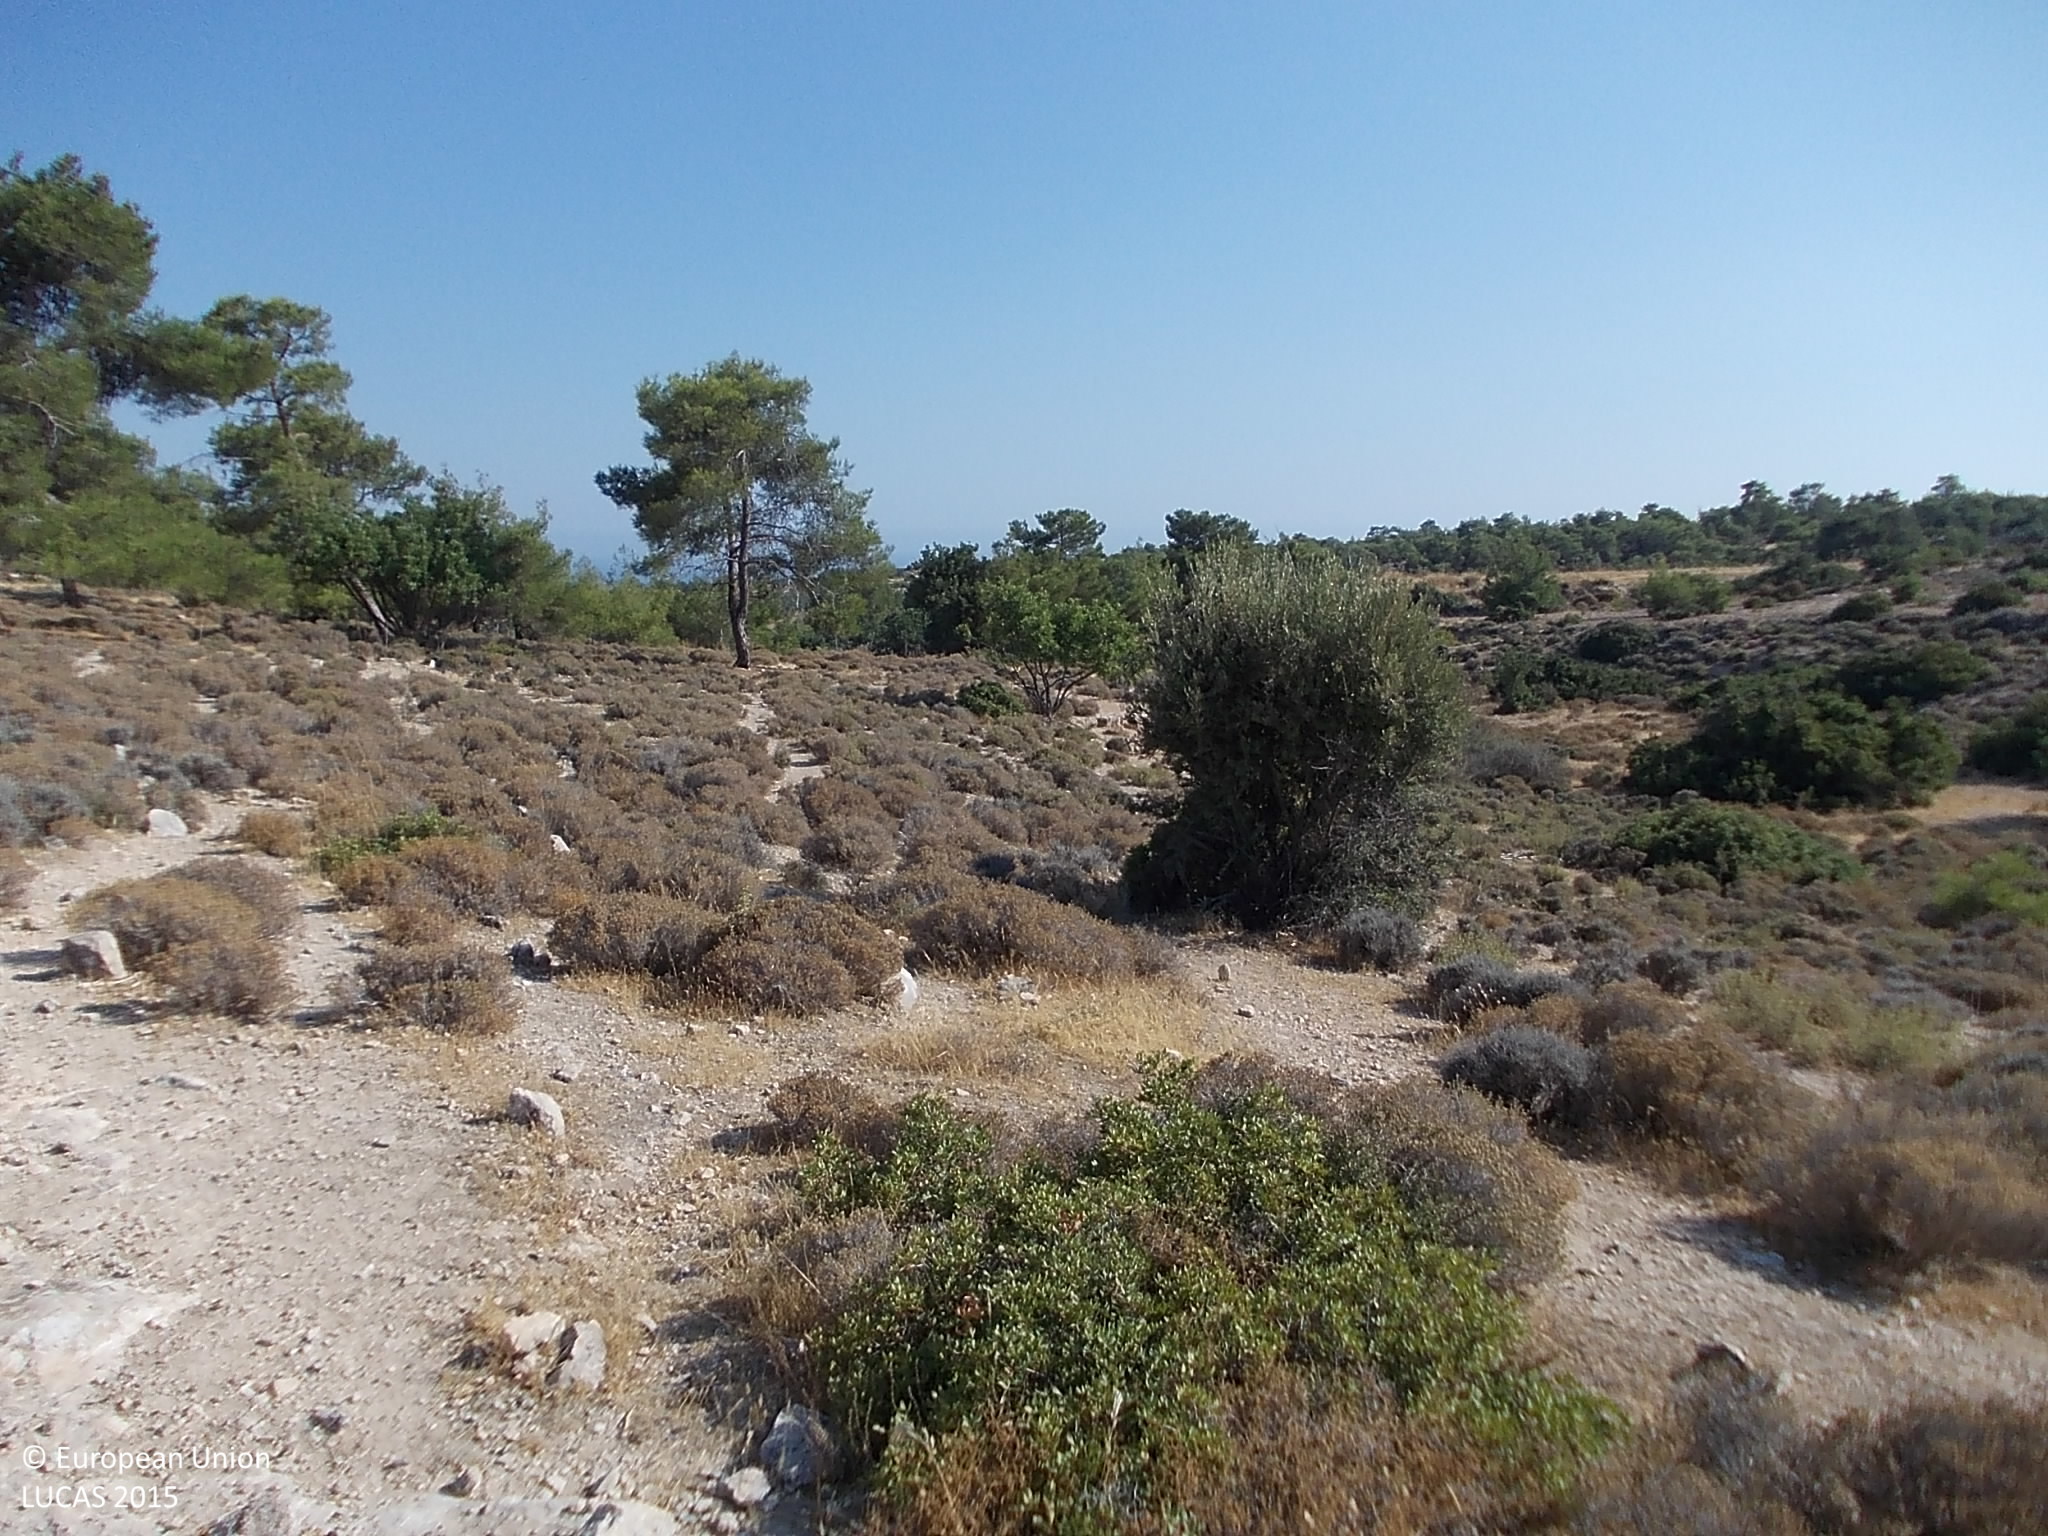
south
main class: Shrubland
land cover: Shrubland without tree cover
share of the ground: 50 - 75 %
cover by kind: shrubs 55 %, unconsolidated bare surface 25 %, herbaceous plants 15 %, consolidated bare surface 5 %
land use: Semi-natural and natural areas not in use
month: August
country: CY
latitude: 34.6891
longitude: 32.8967
